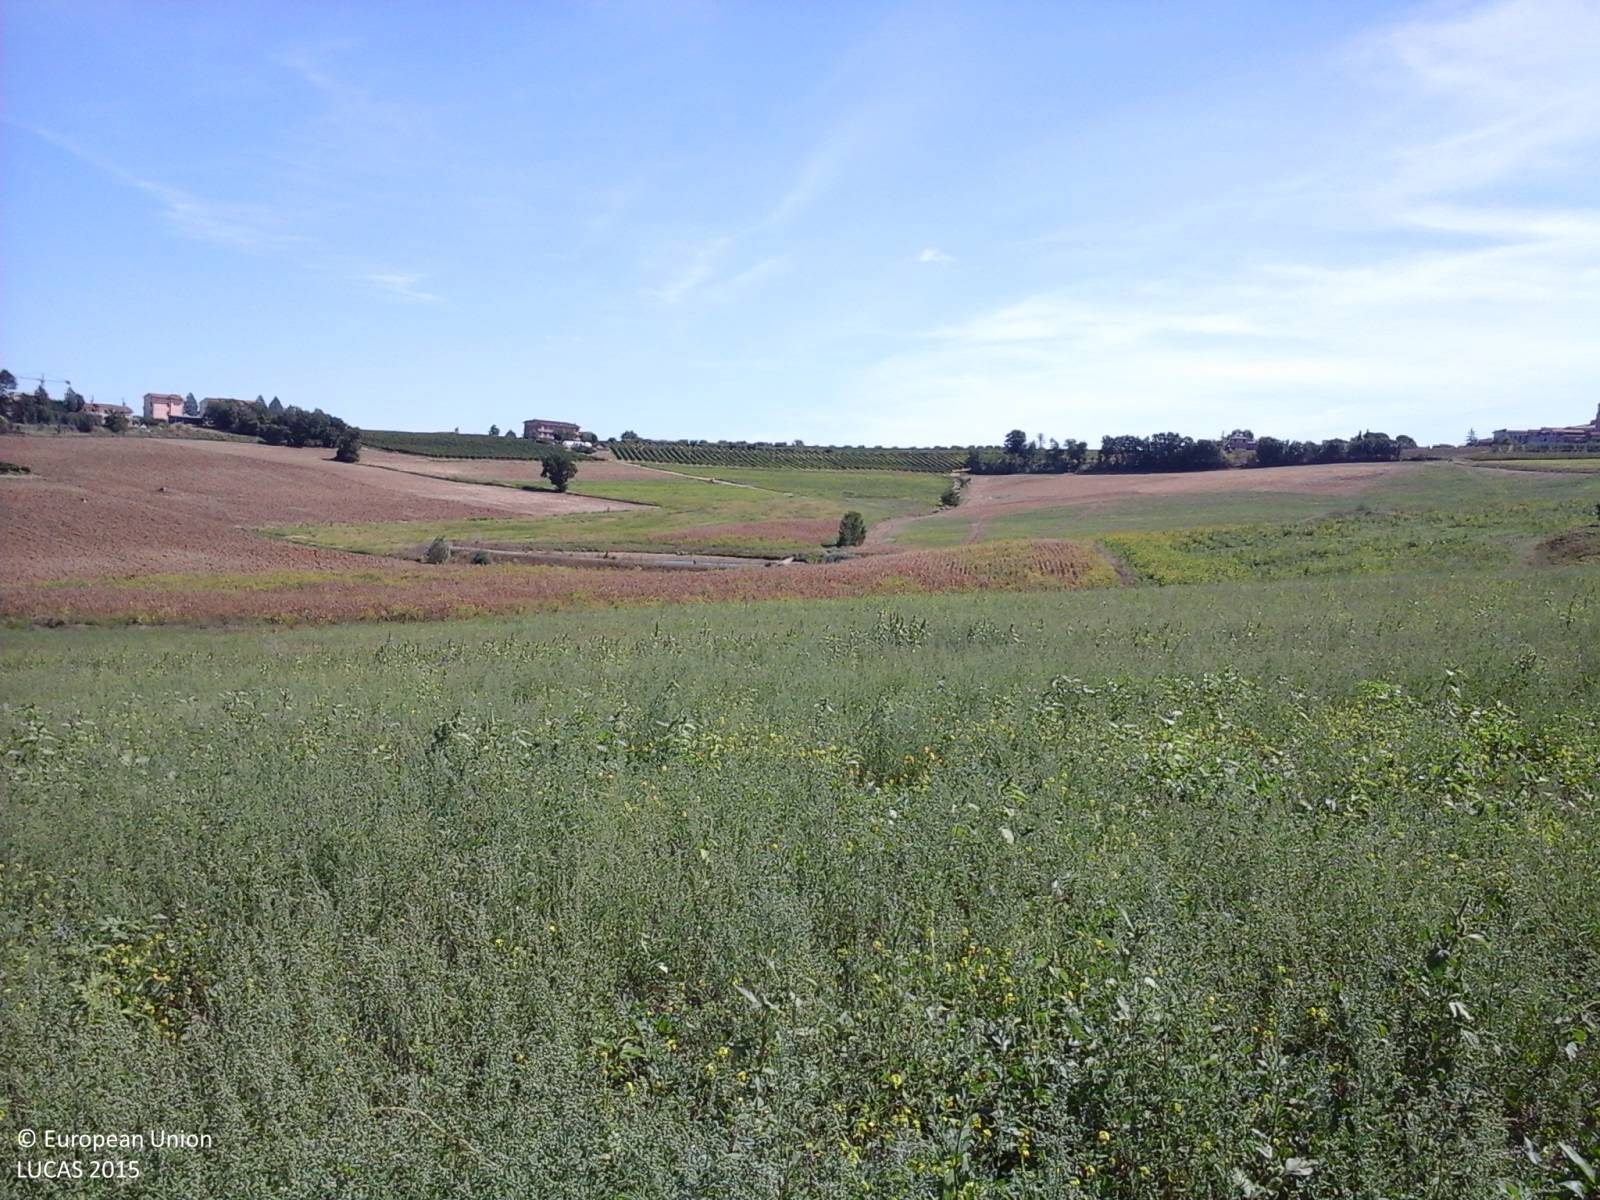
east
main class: Grassland
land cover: Spontaneously vegetated surfaces
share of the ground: > 75 %
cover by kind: herbaceous plants 100 %
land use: Fallow land
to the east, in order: Spontaneously vegetated surfaces; Ditches and canals; Spontaneously vegetated surfaces; Sunflower
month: September
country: IT
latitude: 42.9709
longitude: 12.3104
